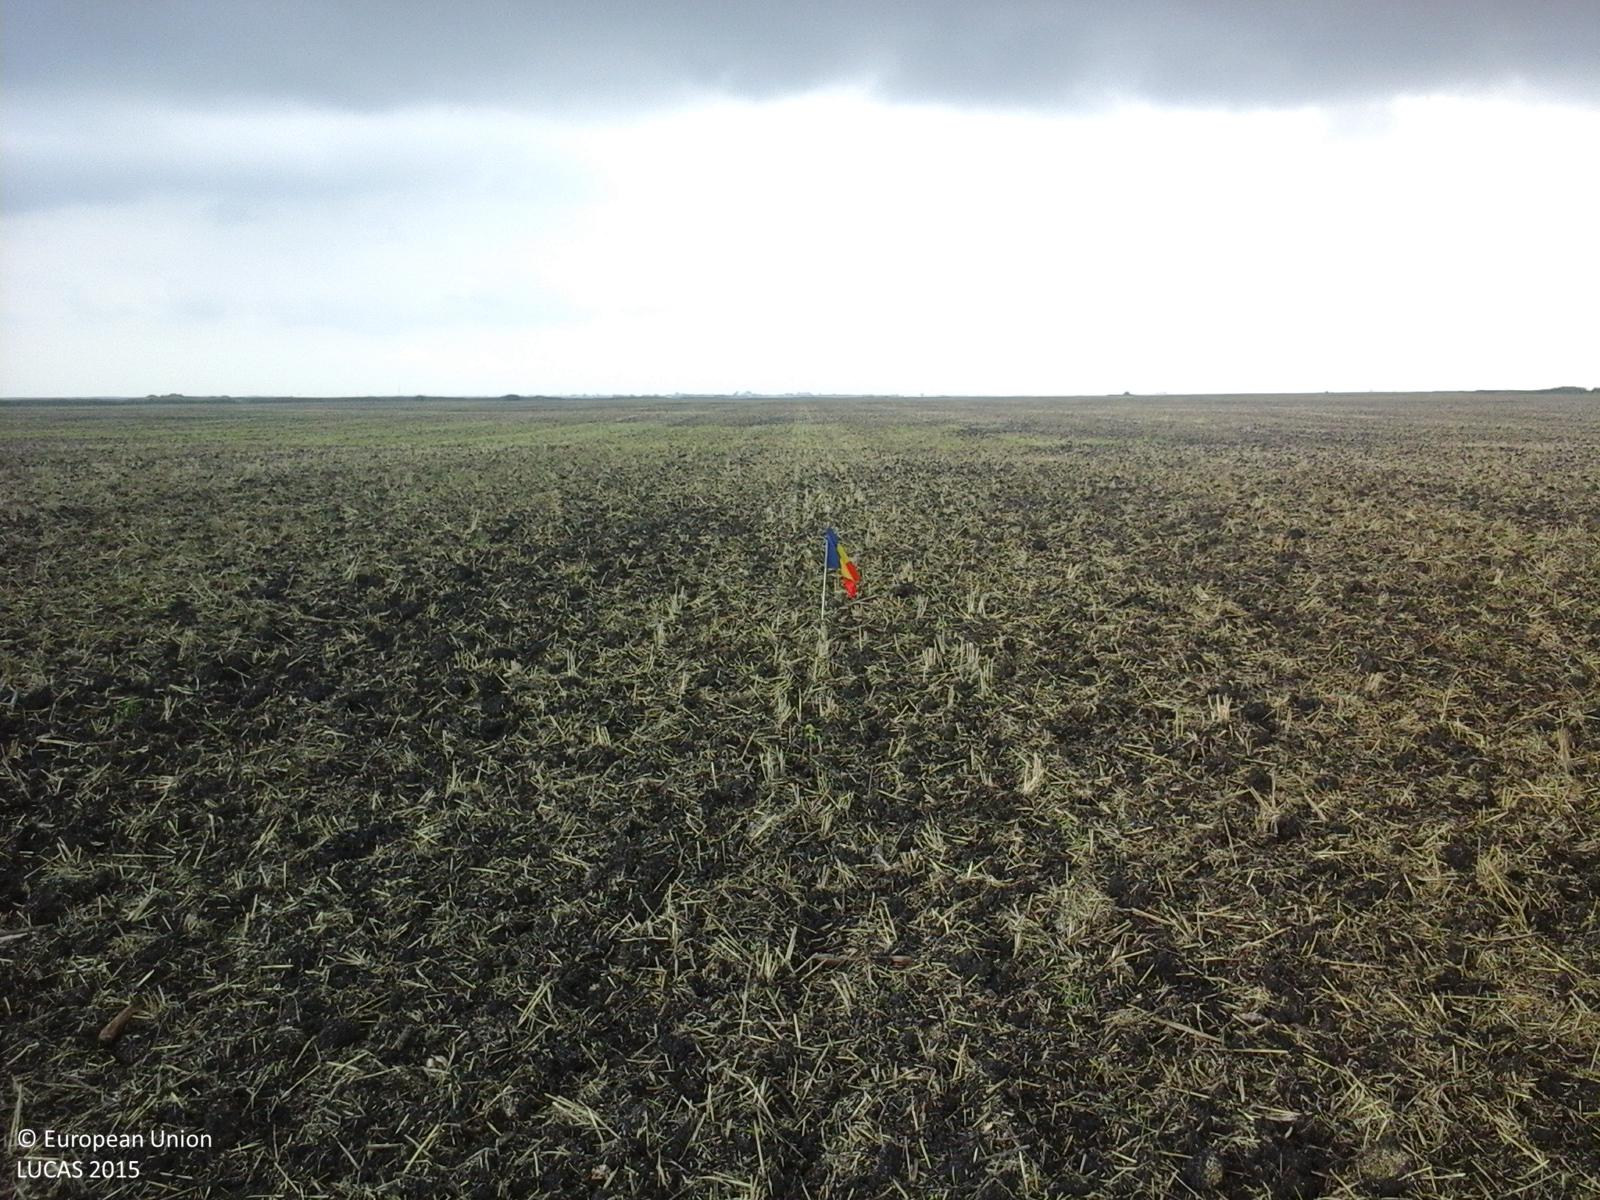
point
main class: Cropland
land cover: Common wheat
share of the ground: < 10 %
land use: Agriculture (excluding fallow land and kitchen gardens)
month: August
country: RO
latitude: 46.0857
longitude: 20.3300
